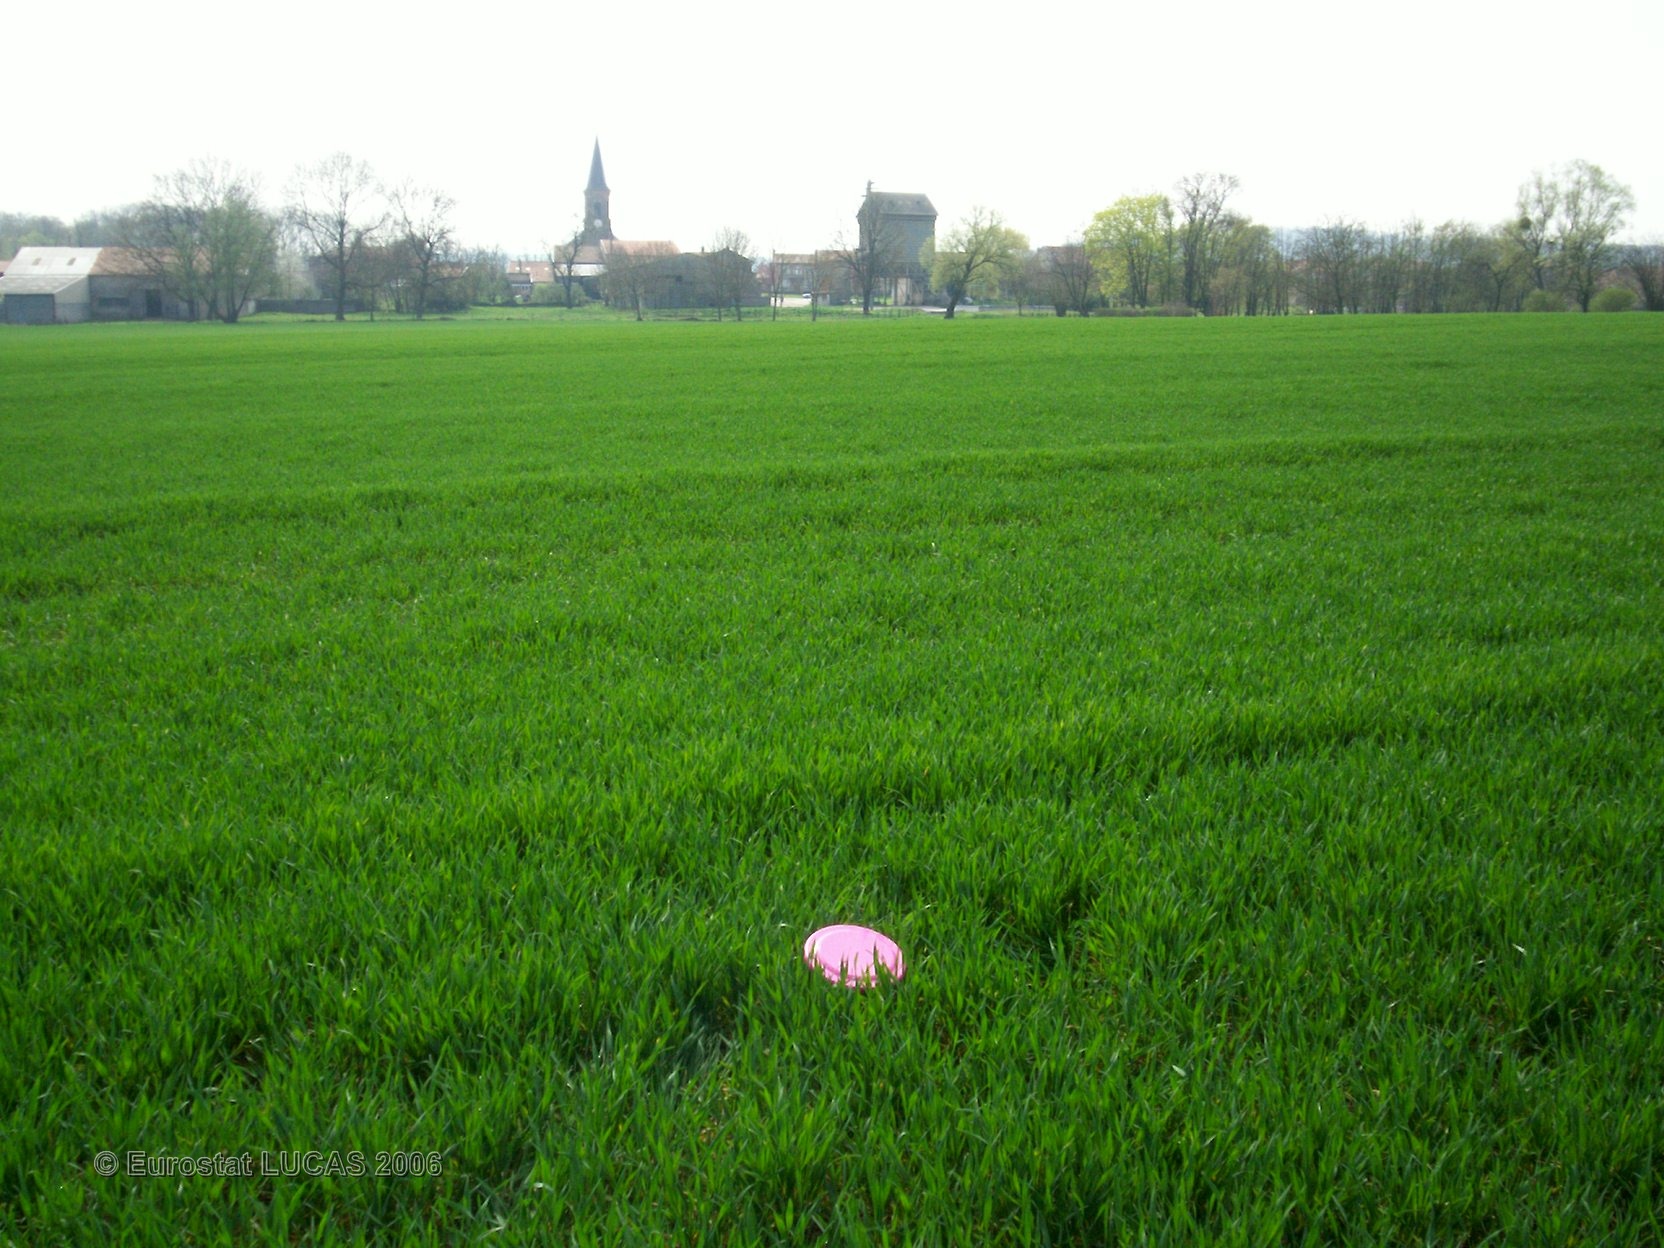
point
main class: Cropland
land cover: Common wheat
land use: Agriculture (excluding fallow land and kitchen gardens)
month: April
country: FR
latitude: 48.7274
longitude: 6.5337
